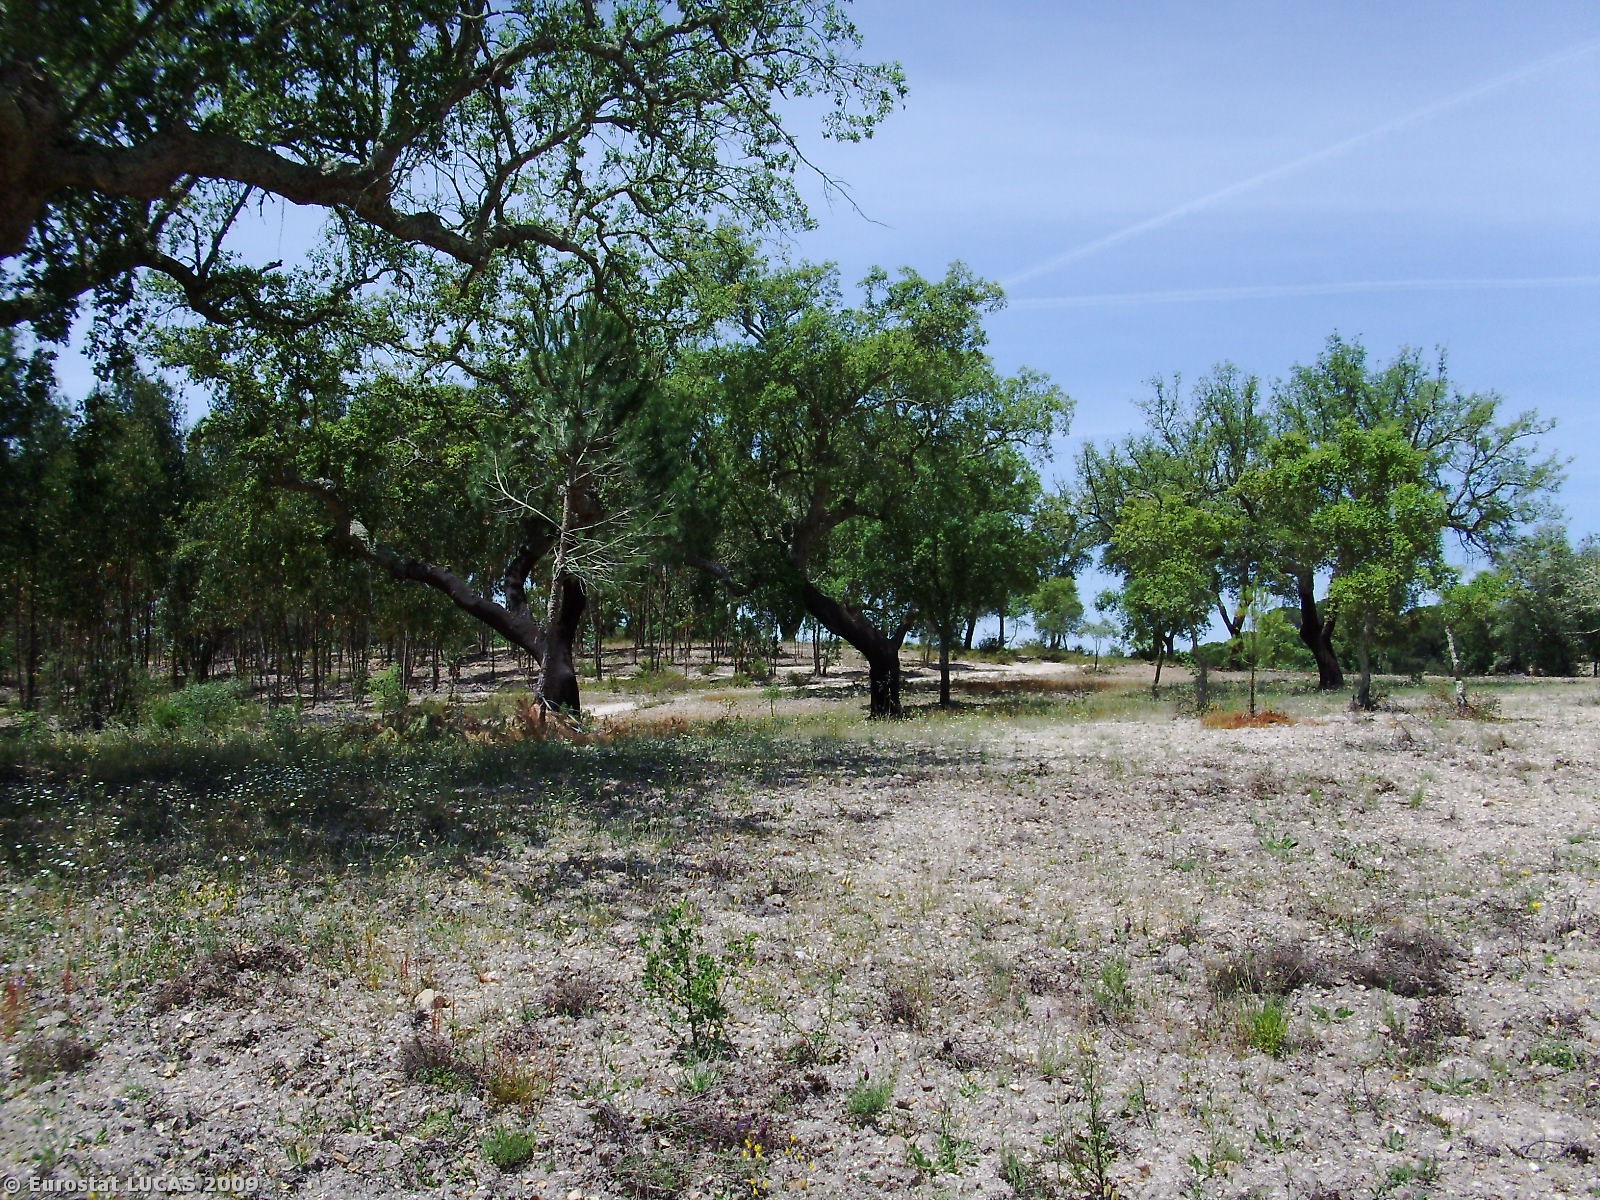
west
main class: Woodland
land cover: Broadleaved woodland
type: broadleaved evergreen forest
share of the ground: 50 - 75 %
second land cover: Bare land
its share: 25 - 50 %
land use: Forestry
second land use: Fallow land
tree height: > 5 m
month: May
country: PT
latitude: 39.1553
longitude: -8.0248
